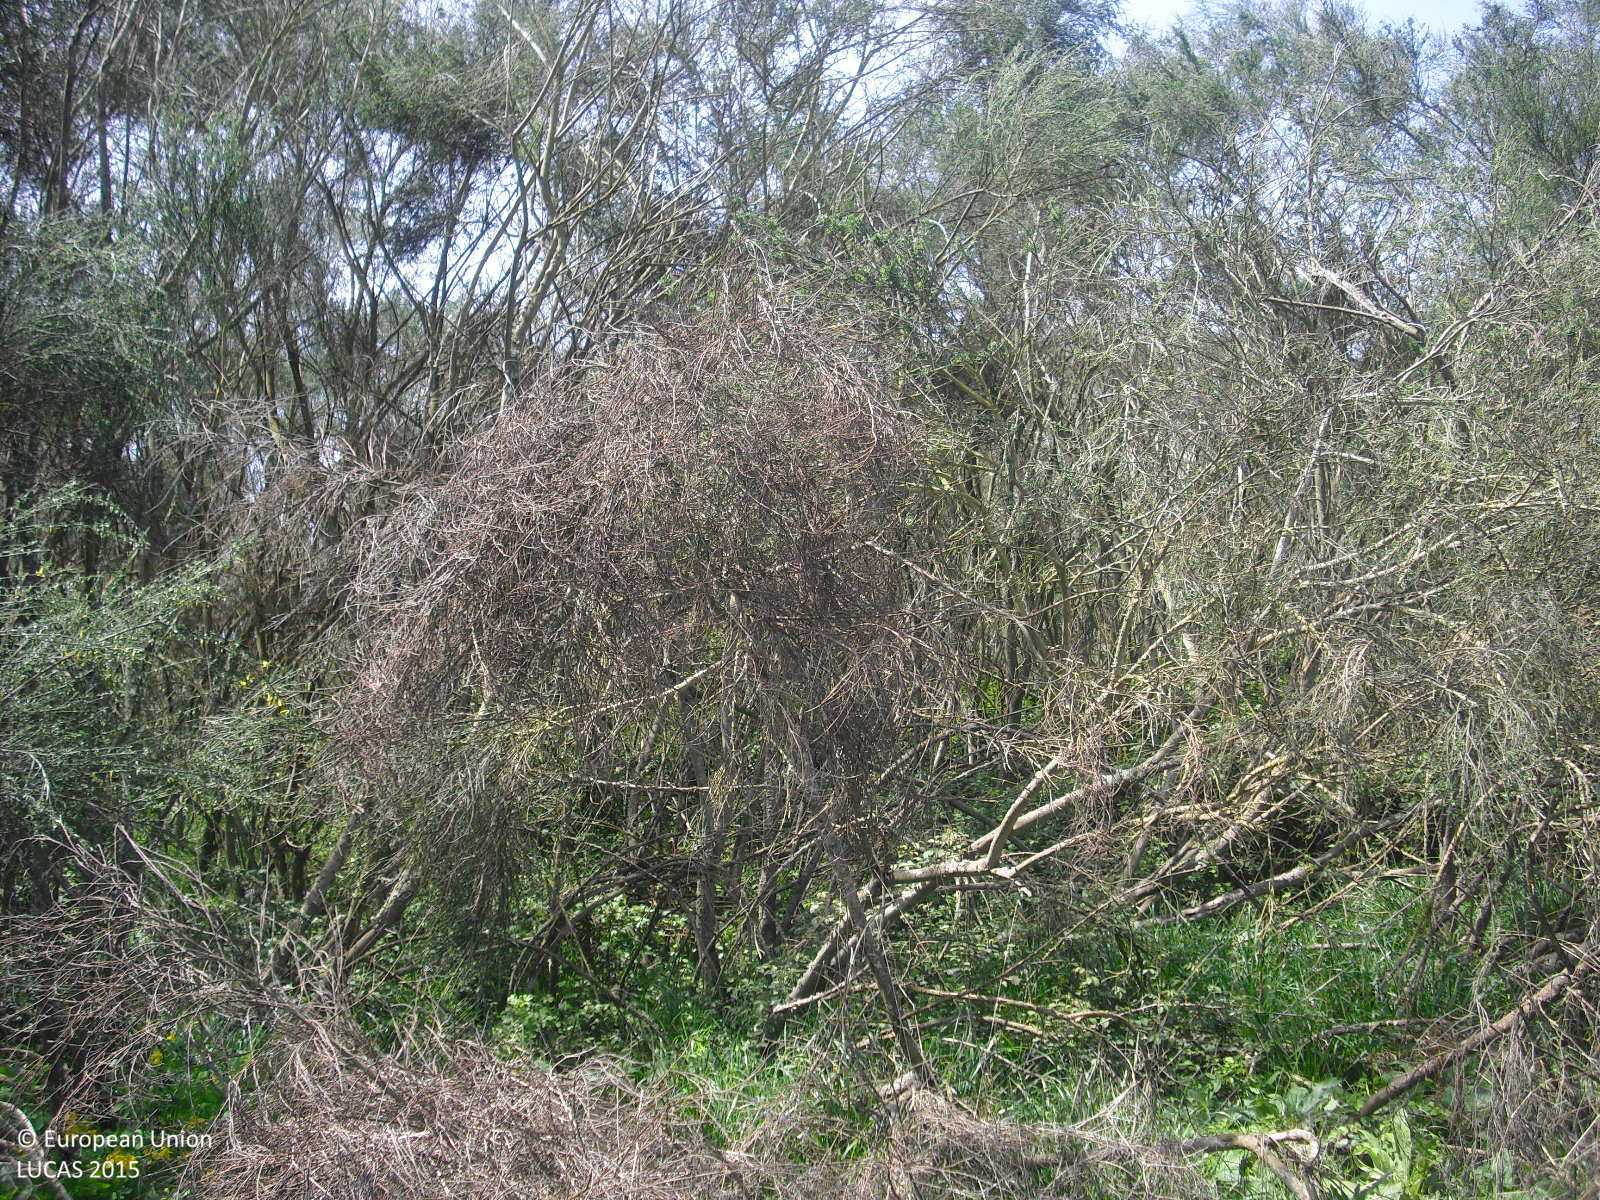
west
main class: Shrubland
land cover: Shrubland without tree cover
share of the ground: > 75 %
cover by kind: shrubs 90 %, herbaceous plants 10 %
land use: Abandoned areas
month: April
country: ES
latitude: 42.0582
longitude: -7.6989
